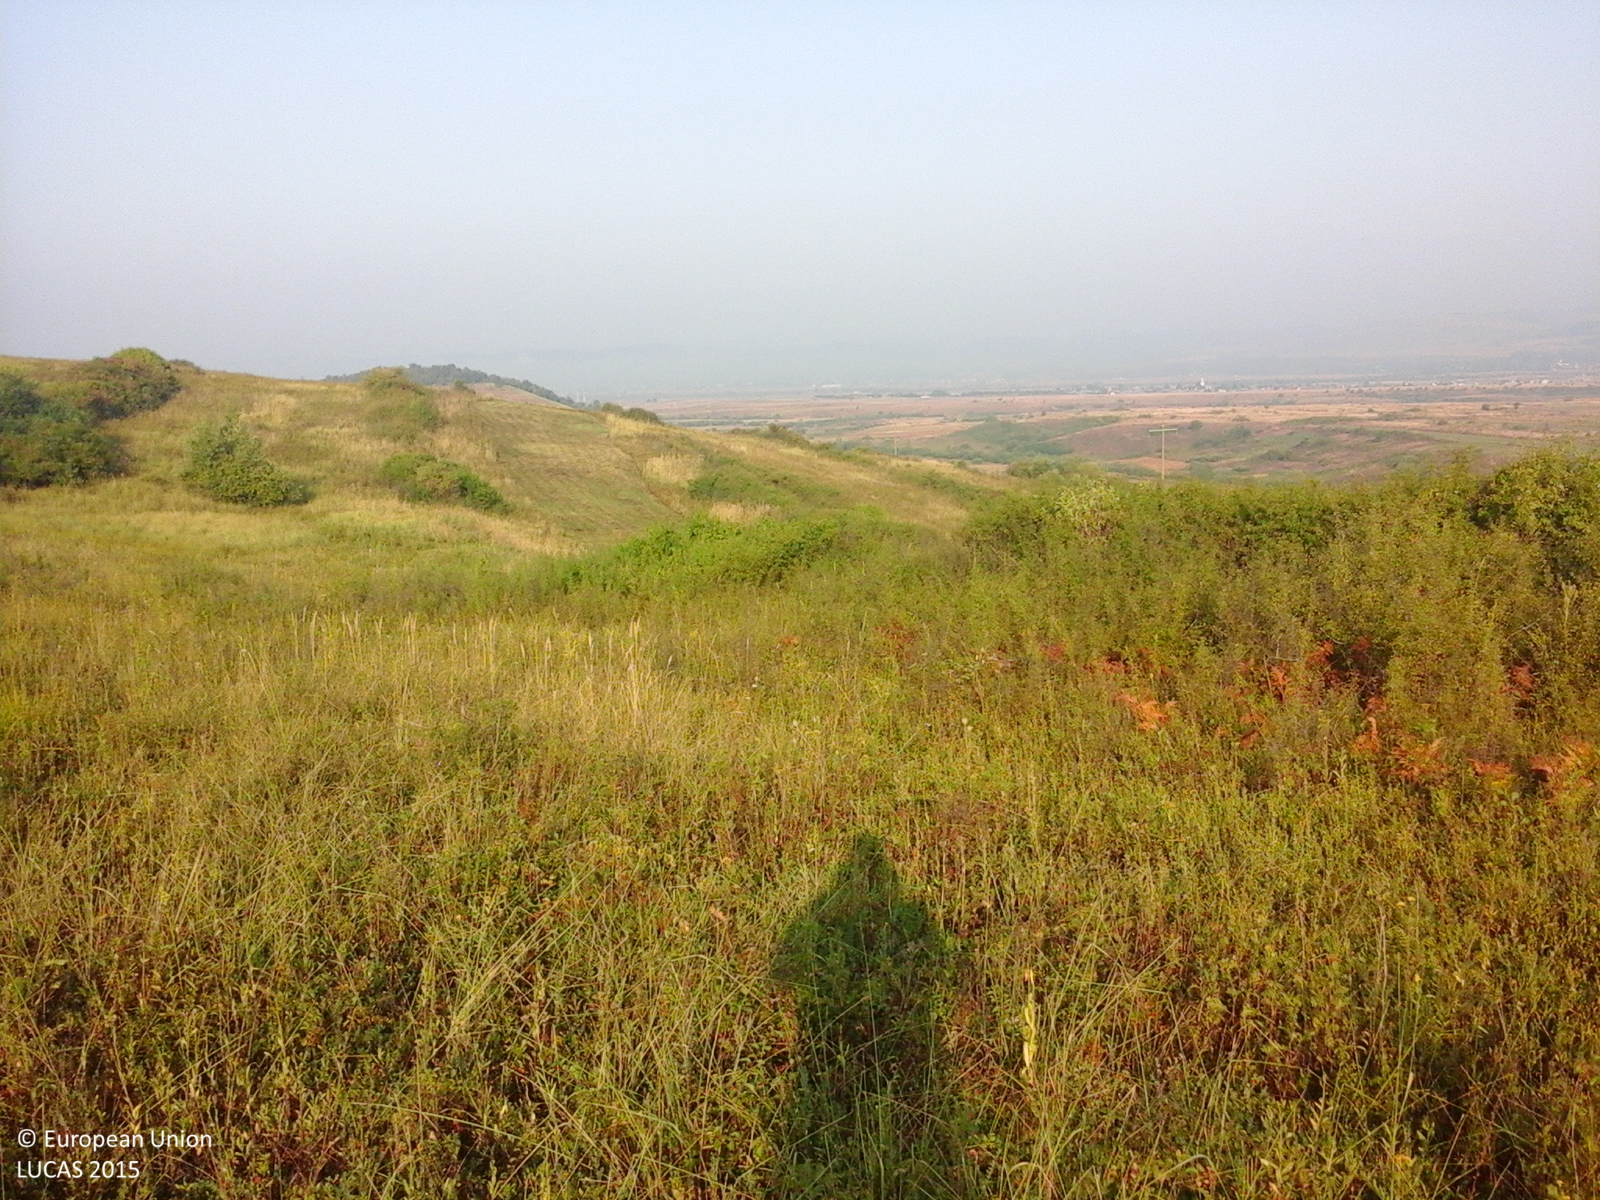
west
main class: Grassland
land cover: Grassland without tree/shrub cover
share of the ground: > 75 %
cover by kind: herbaceous plants 100 %
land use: Agriculture (excluding fallow land and kitchen gardens)
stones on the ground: < 10 %
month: September
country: RO
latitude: 47.2287
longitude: 24.3123
